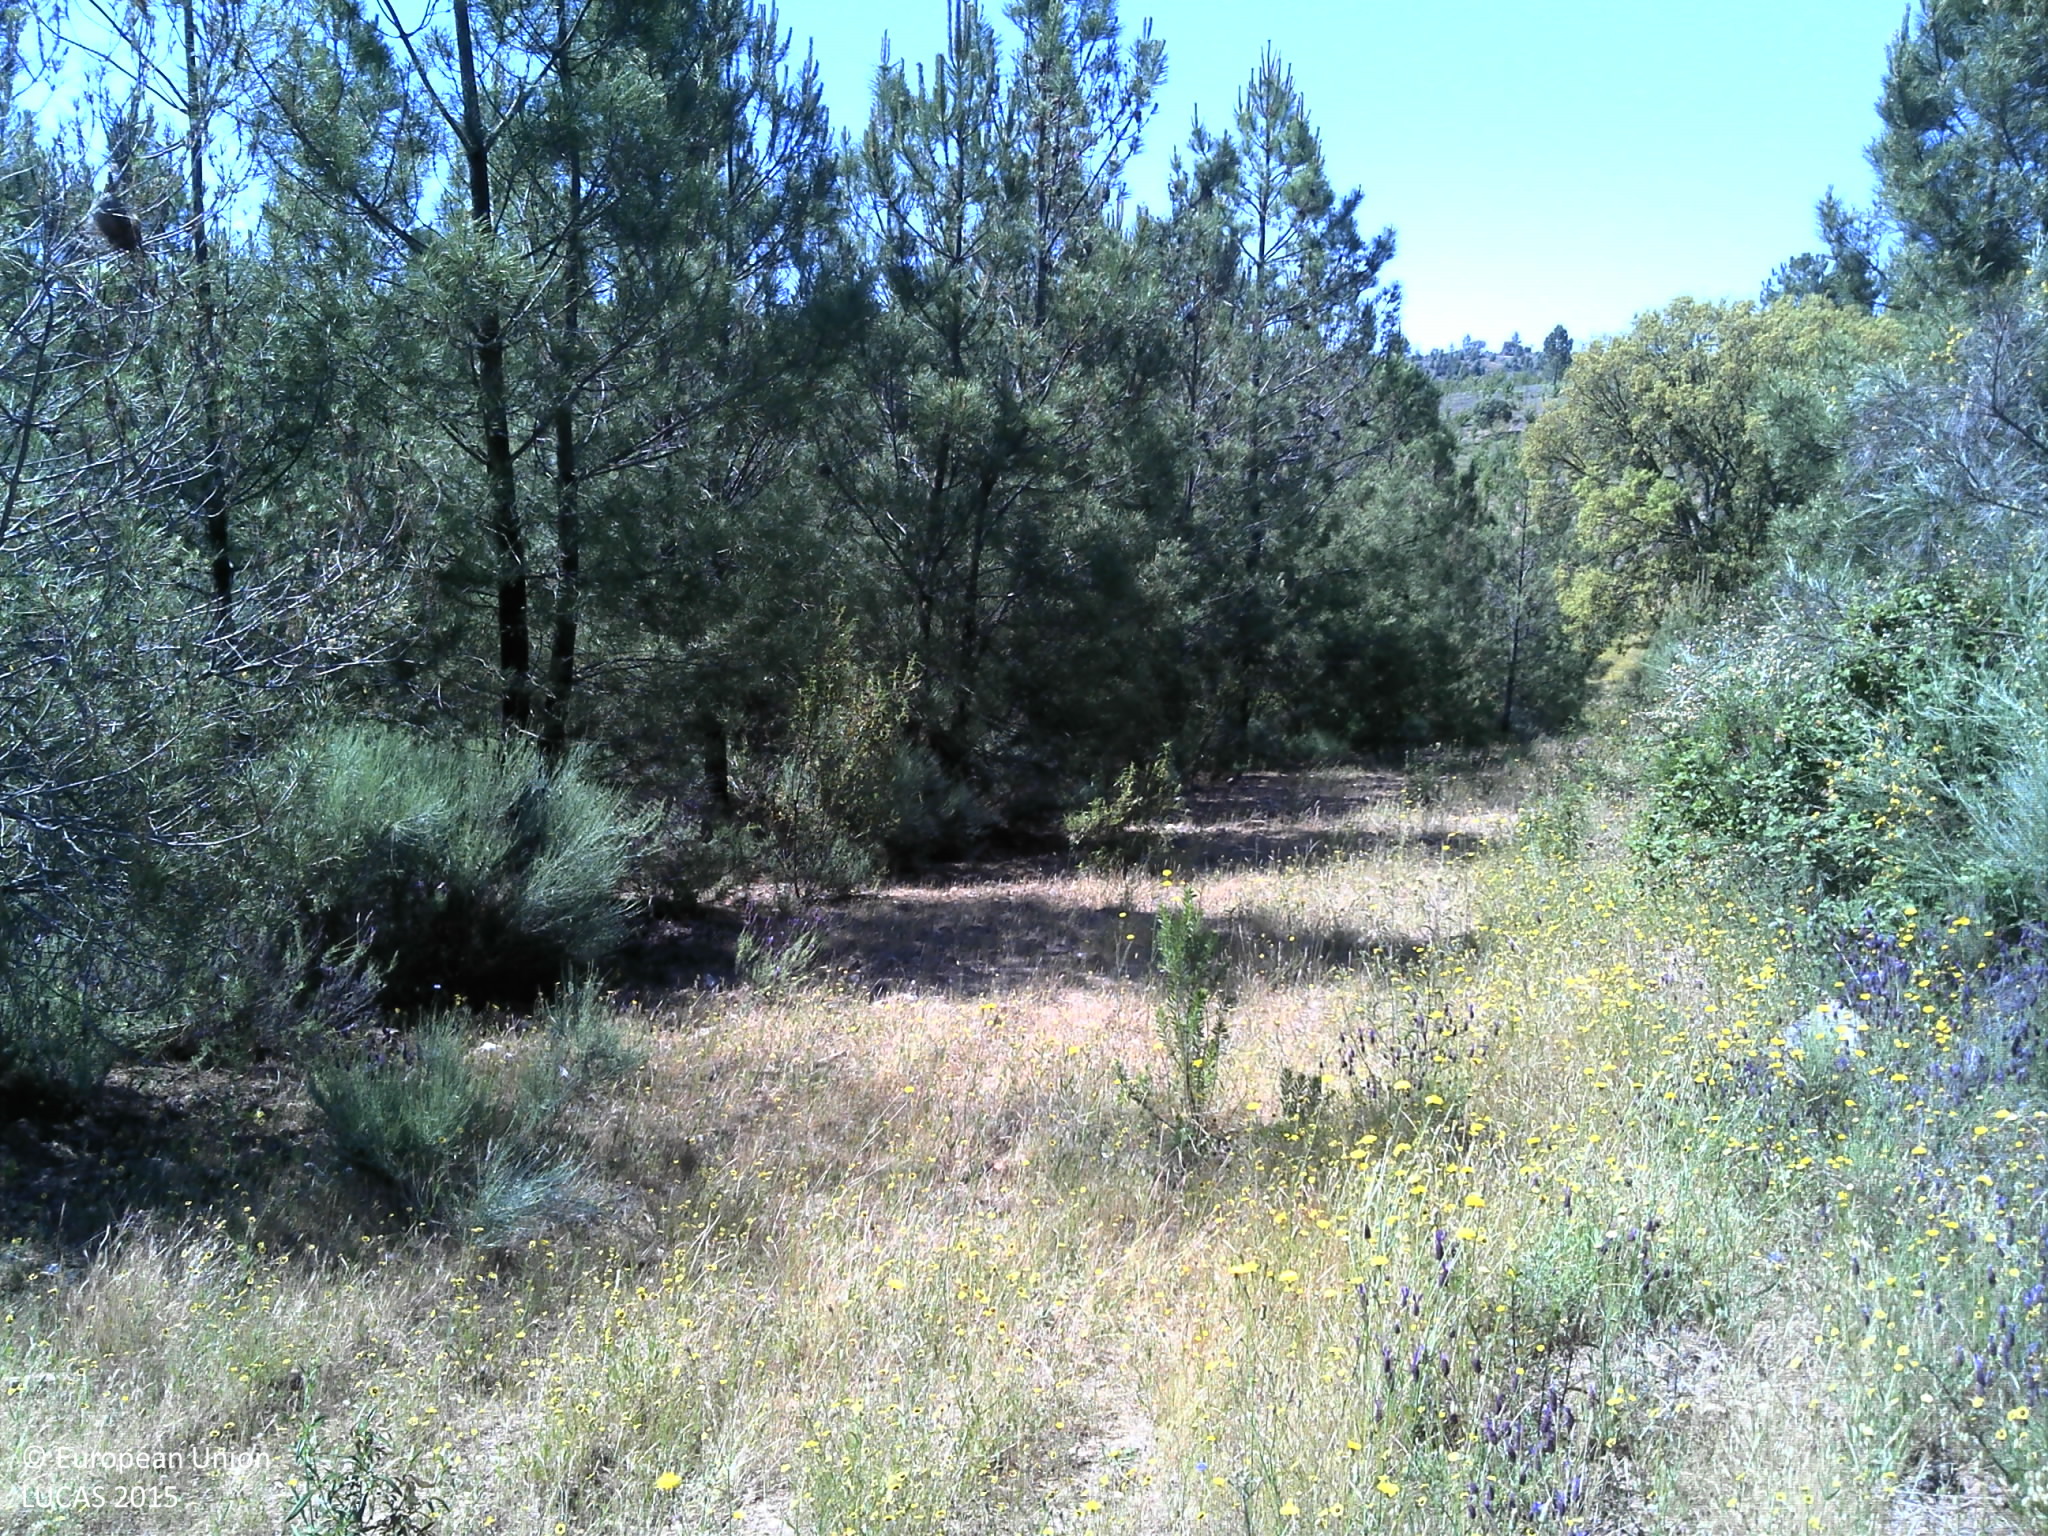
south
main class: Shrubland
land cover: Shrubland with sparse tree cover
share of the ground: > 75 %
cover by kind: shrubs 95 %, broadleaved forest trees 5 %
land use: Abandoned areas
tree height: > 5 m
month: May
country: PT
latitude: 41.1218
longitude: -6.8391
